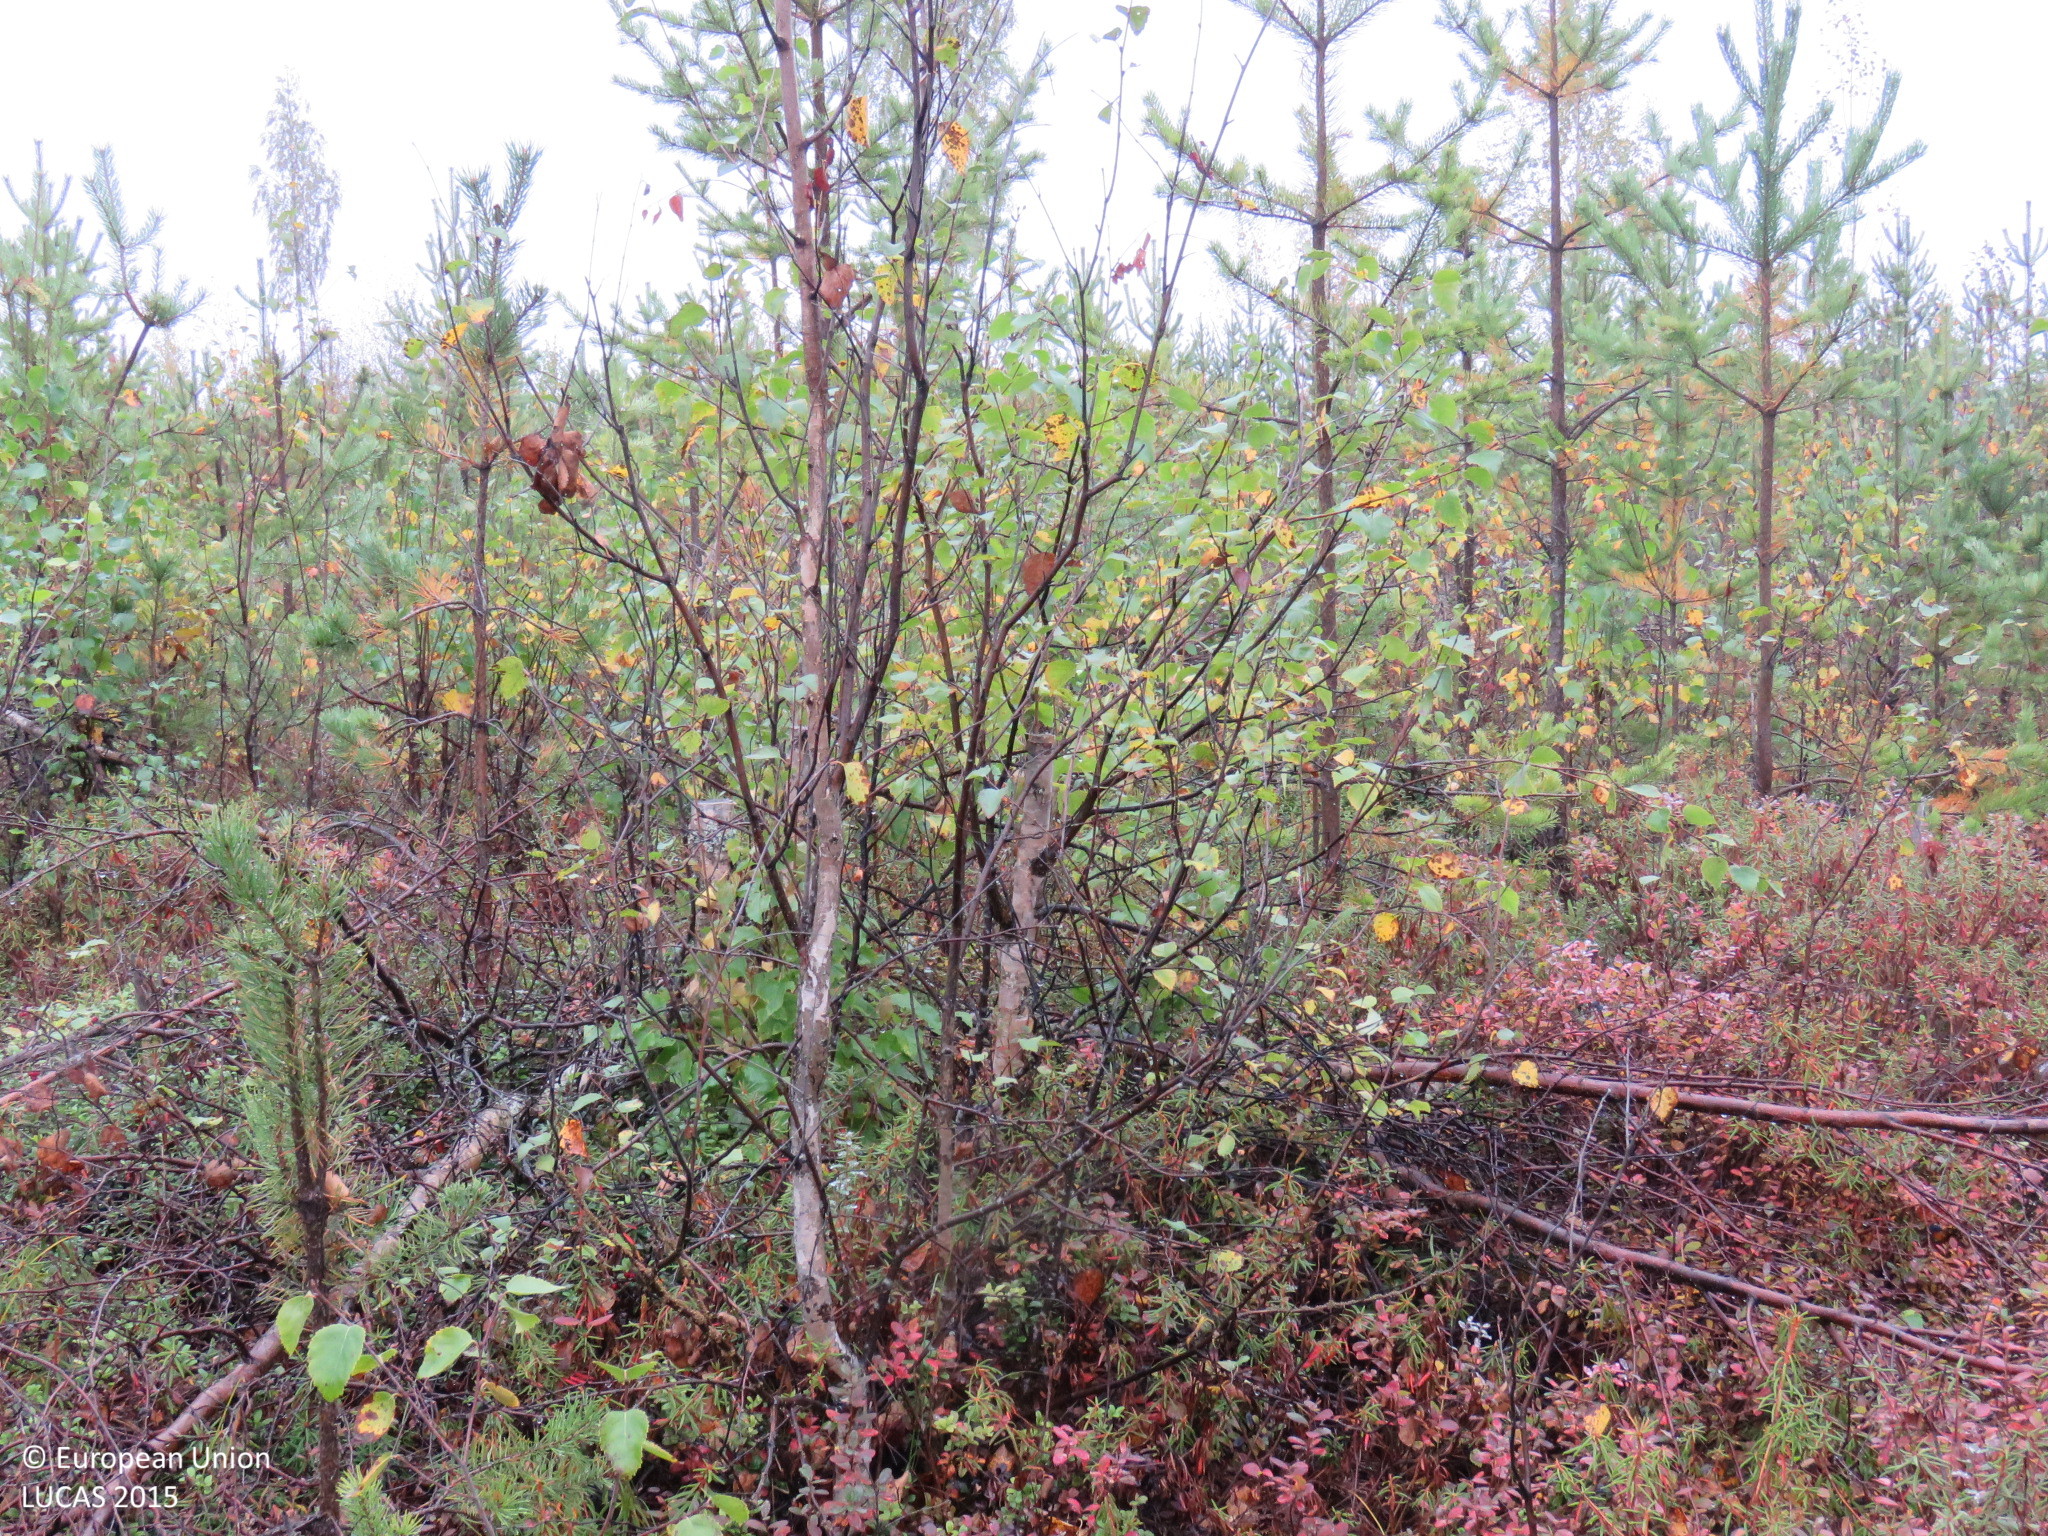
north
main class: Woodland
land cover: Pine dominated mixed woodland
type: boreal forest
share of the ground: 50 - 75 %
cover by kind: coniferous forest trees 30 %, shrubs 30 %, broadleaved forest trees 20 %, lichens and mosses 15 %, herbaceous plants 5 %
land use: Forestry
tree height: < 5 m
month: September
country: FI
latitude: 64.8346
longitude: 26.5729
